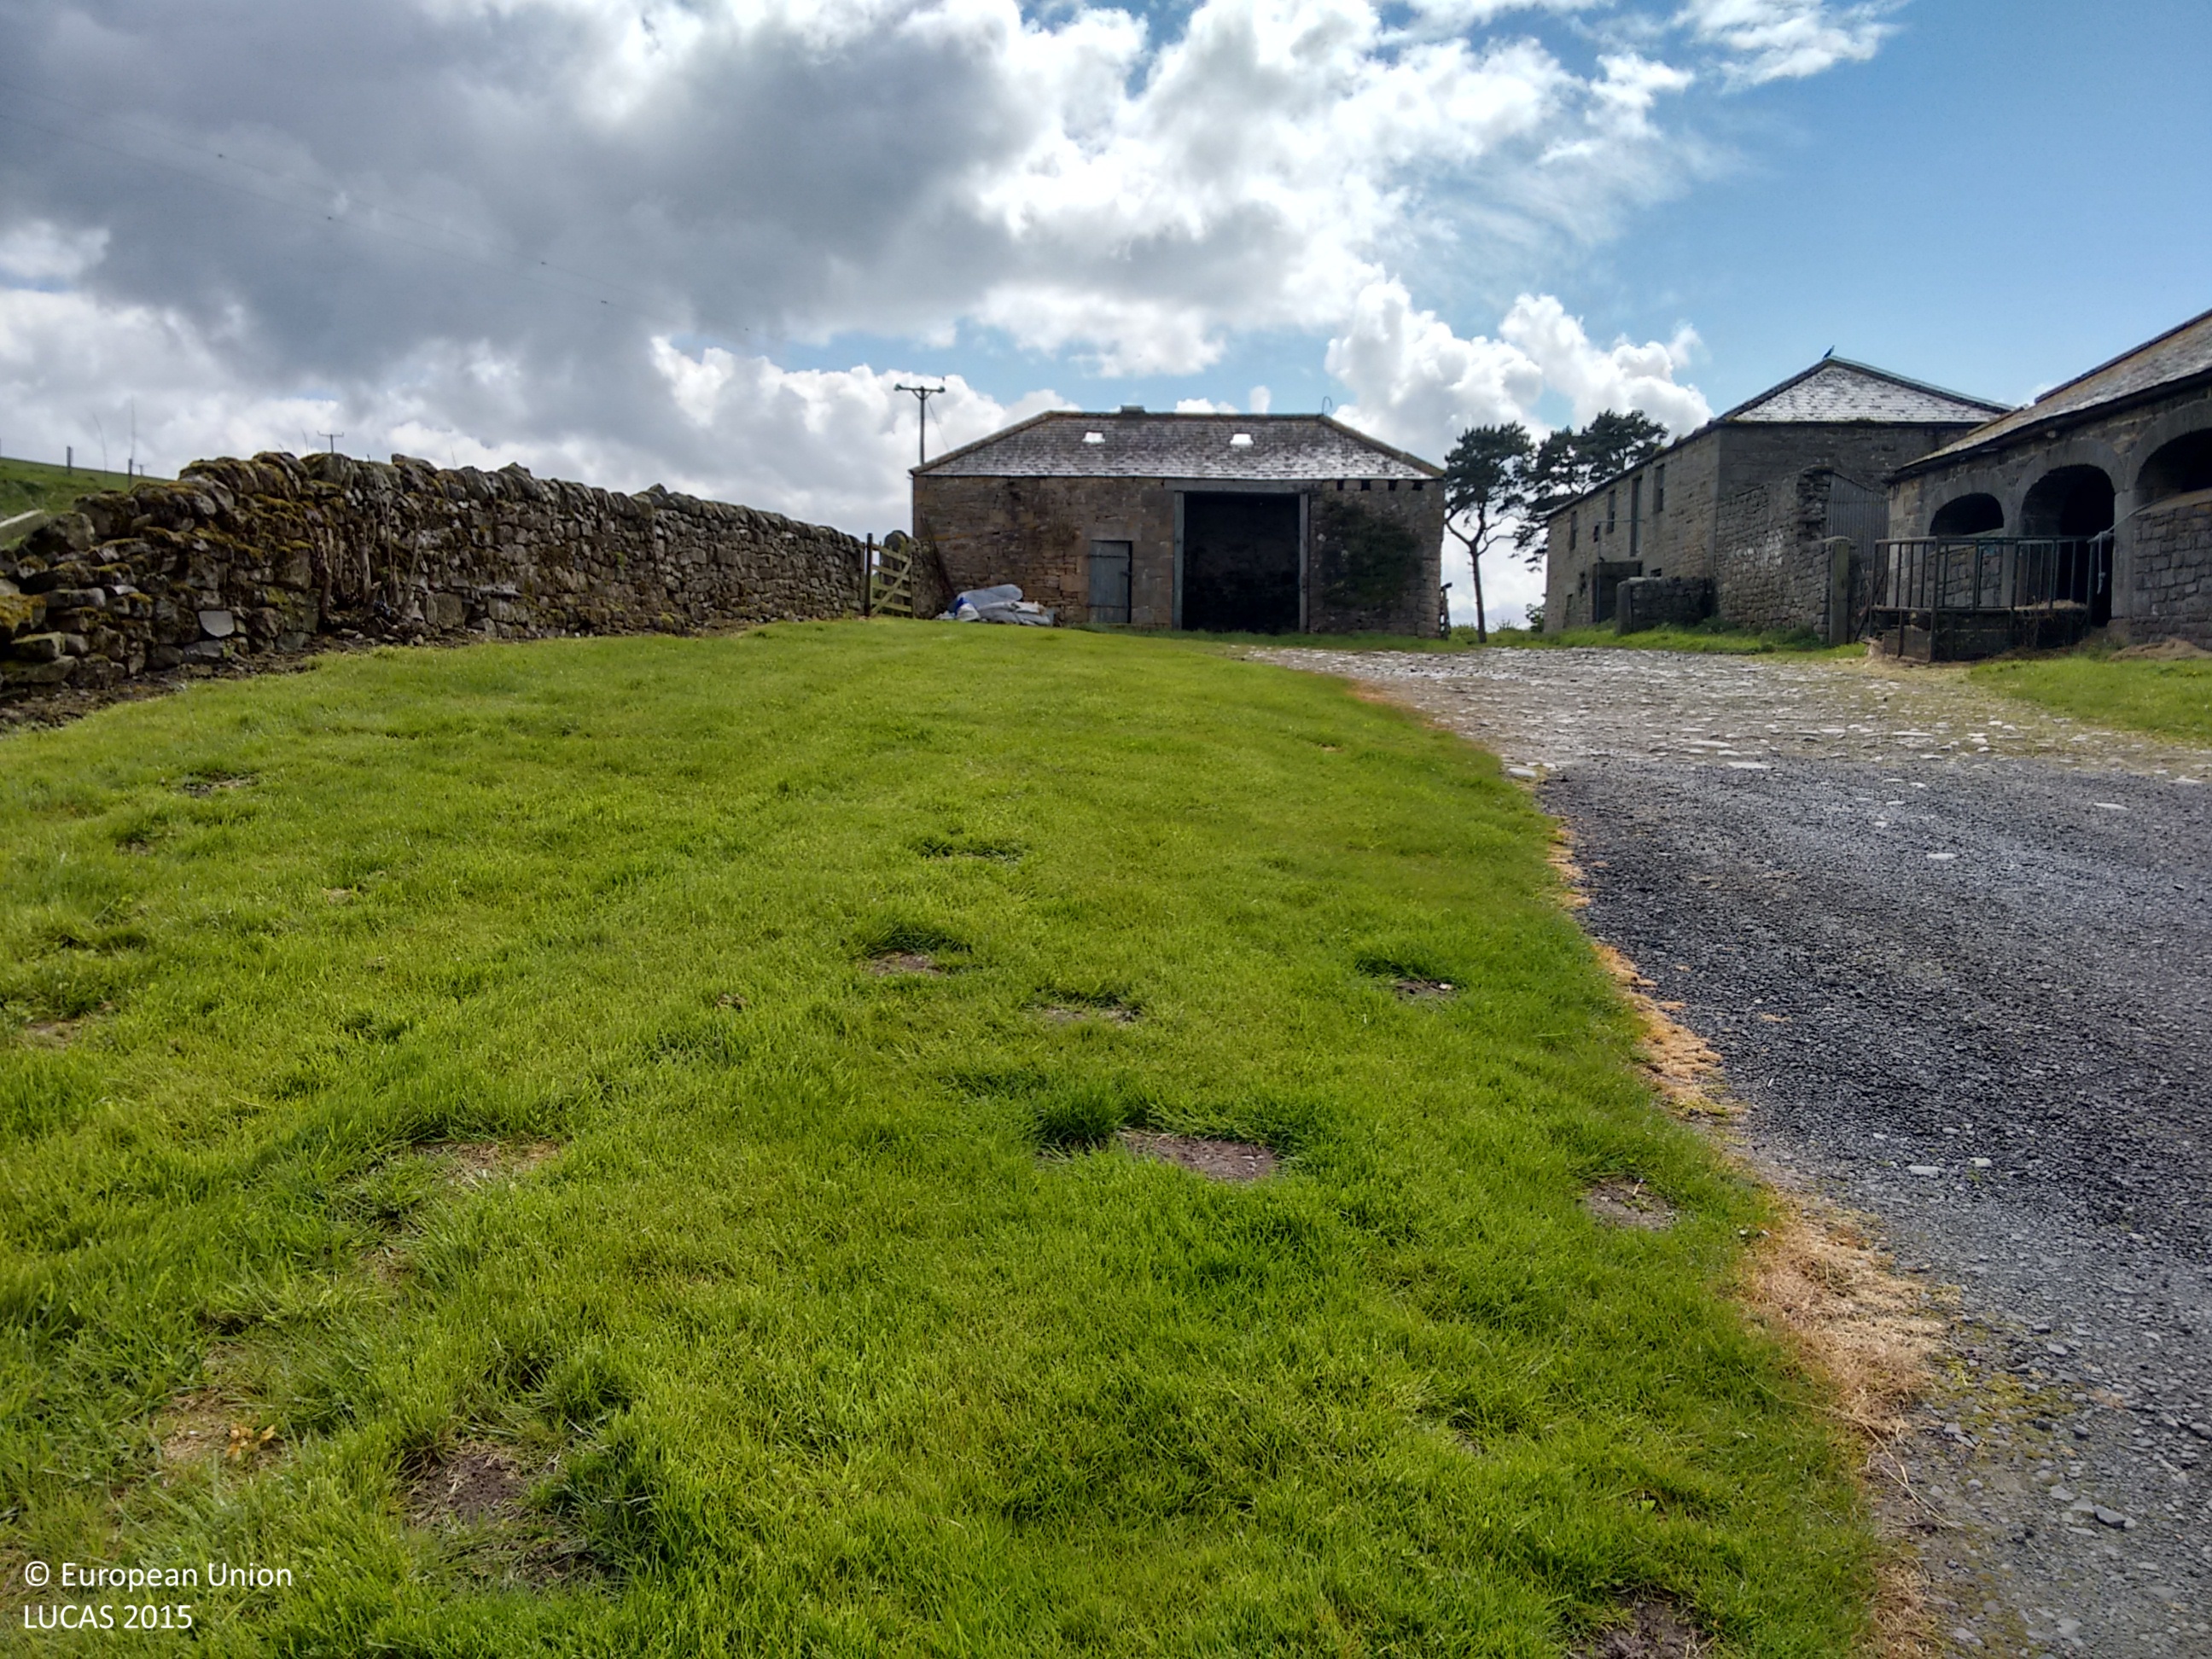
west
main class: Woodland
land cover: Pine dominated mixed woodland
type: exotic forest
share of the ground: > 75 %
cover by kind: coniferous forest trees 75 %, broadleaved forest trees 25 %
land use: Forestry
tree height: > 5 m
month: May
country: GB
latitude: 54.9841
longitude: -2.1997
